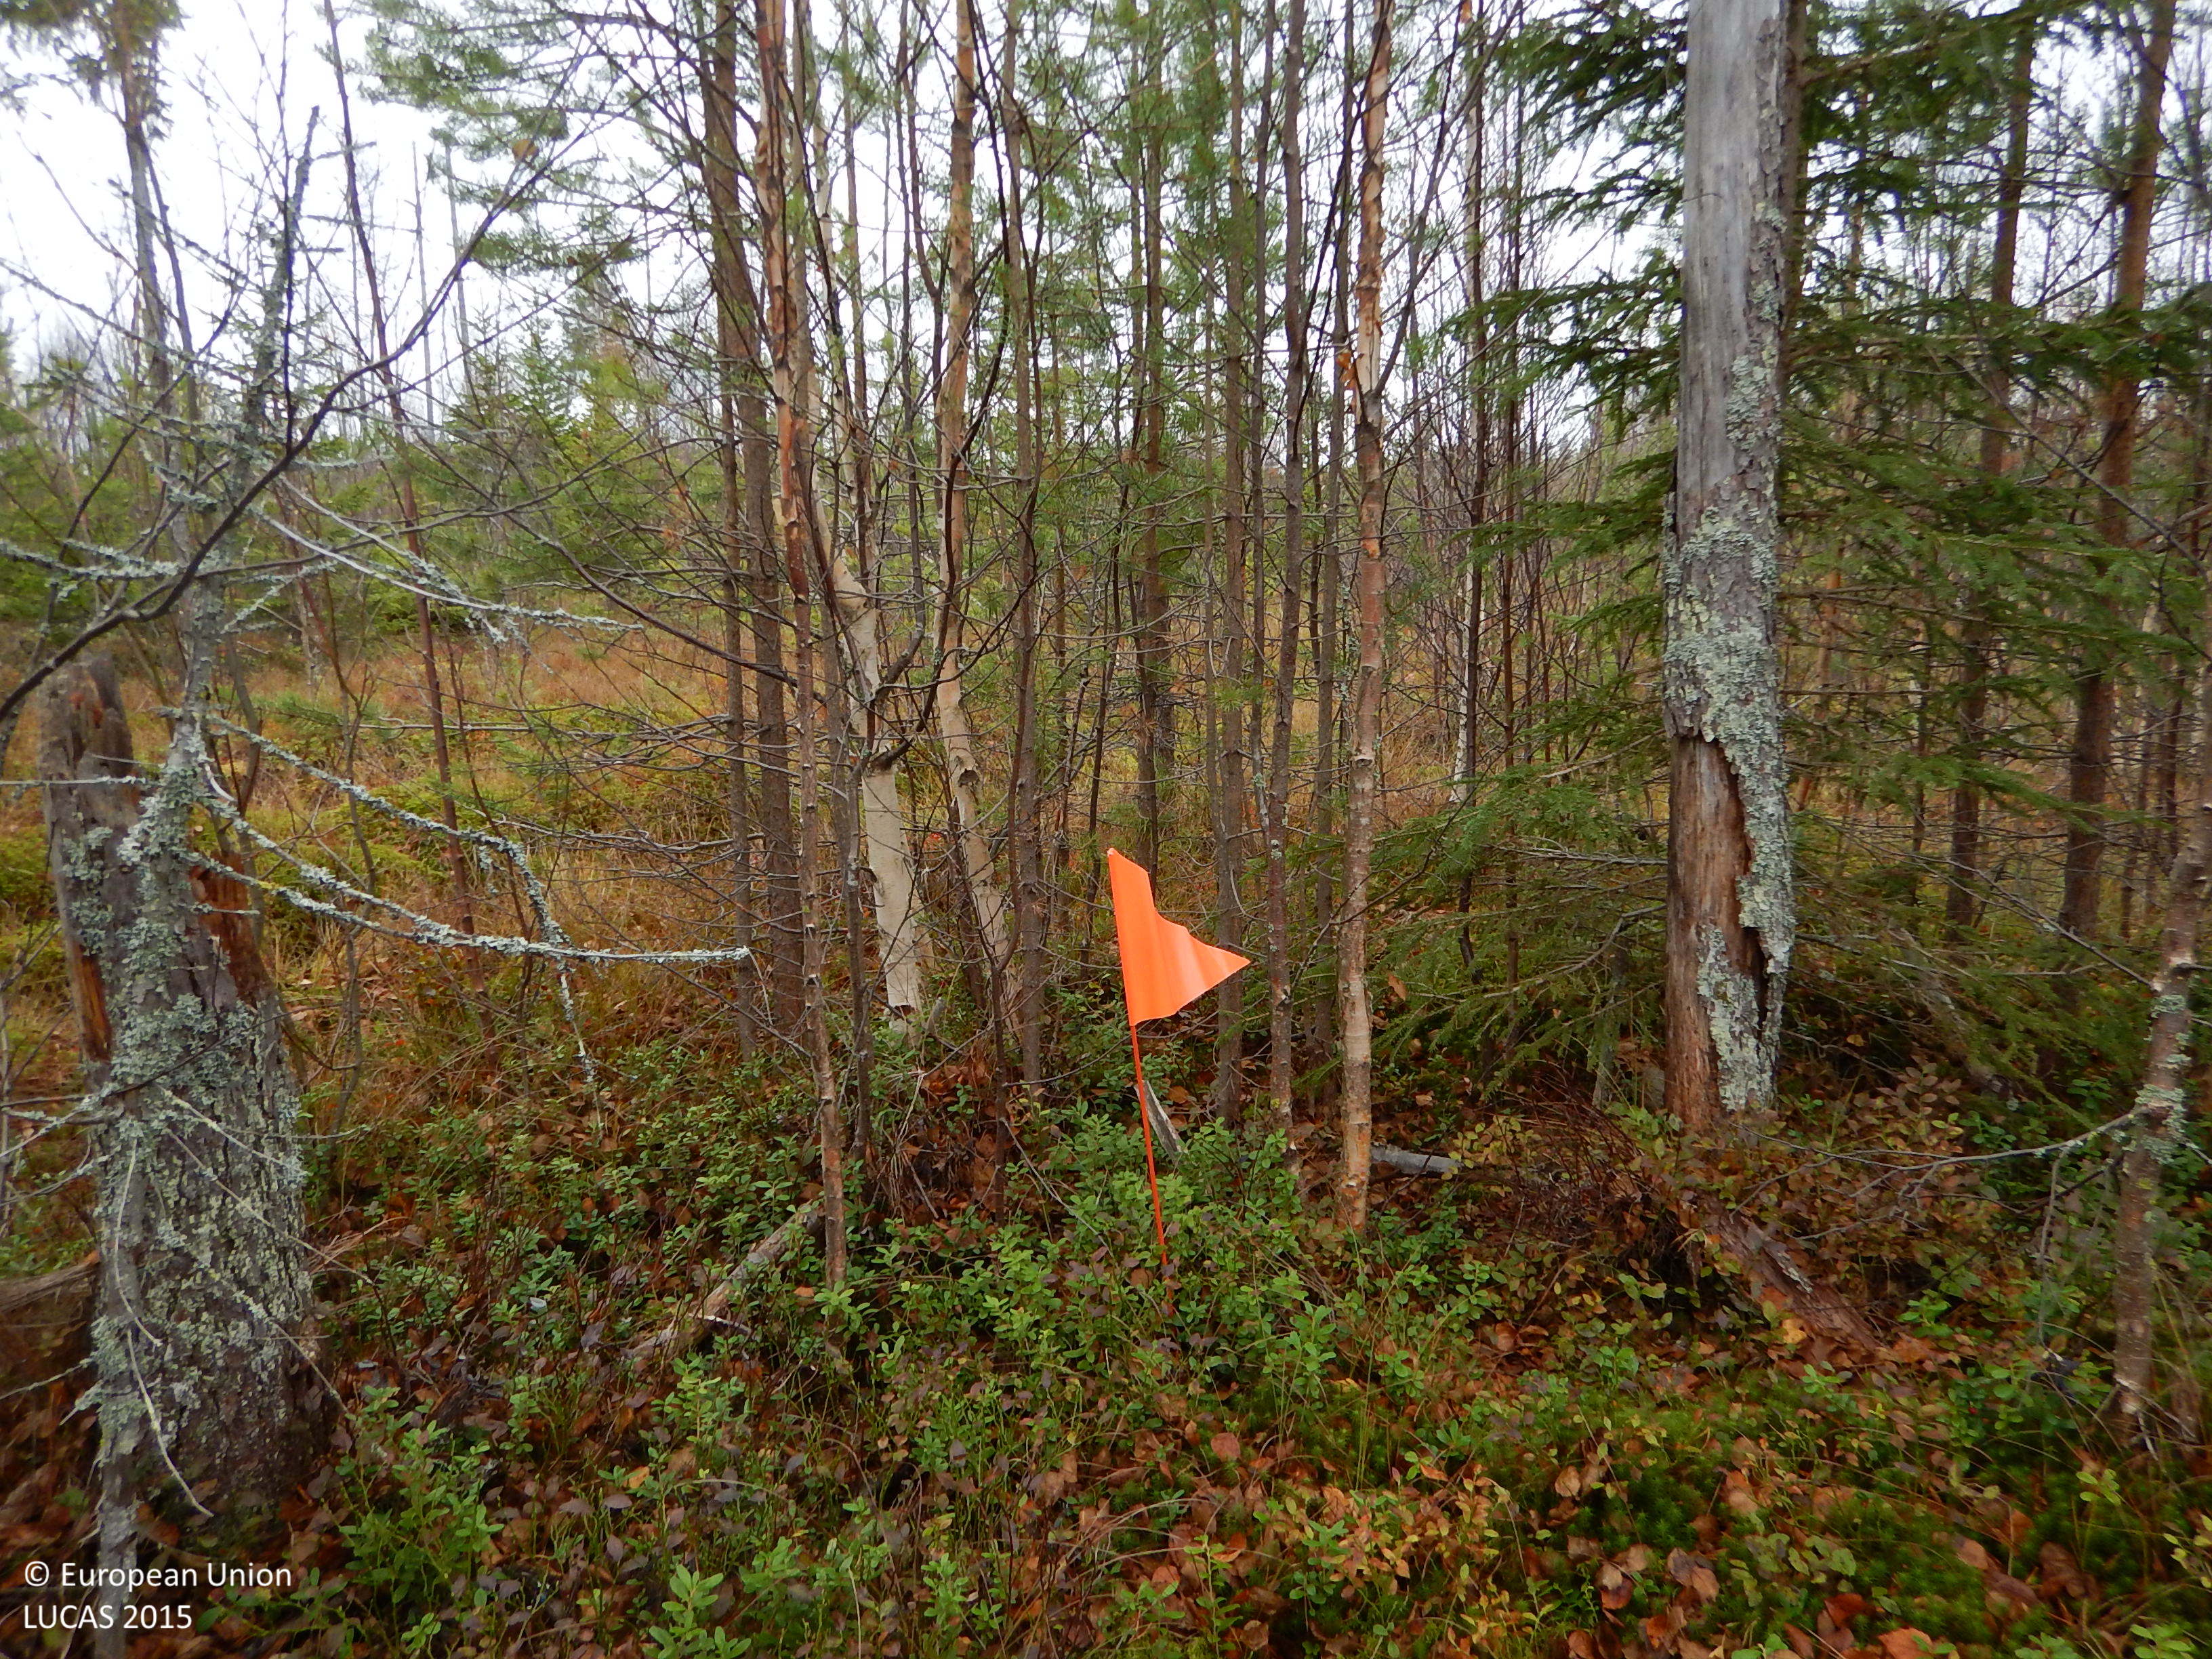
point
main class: Woodland
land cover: Other mixed woodland
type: boreal forest
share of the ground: 50 - 75 %
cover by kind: coniferous forest trees 30 %, broadleaved forest trees 20 %, shrubs 20 %, lichens and mosses 20 %, herbaceous plants 10 %
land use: Forestry
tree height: < 5 m
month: October
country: SE
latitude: 64.9558
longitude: 21.1348
